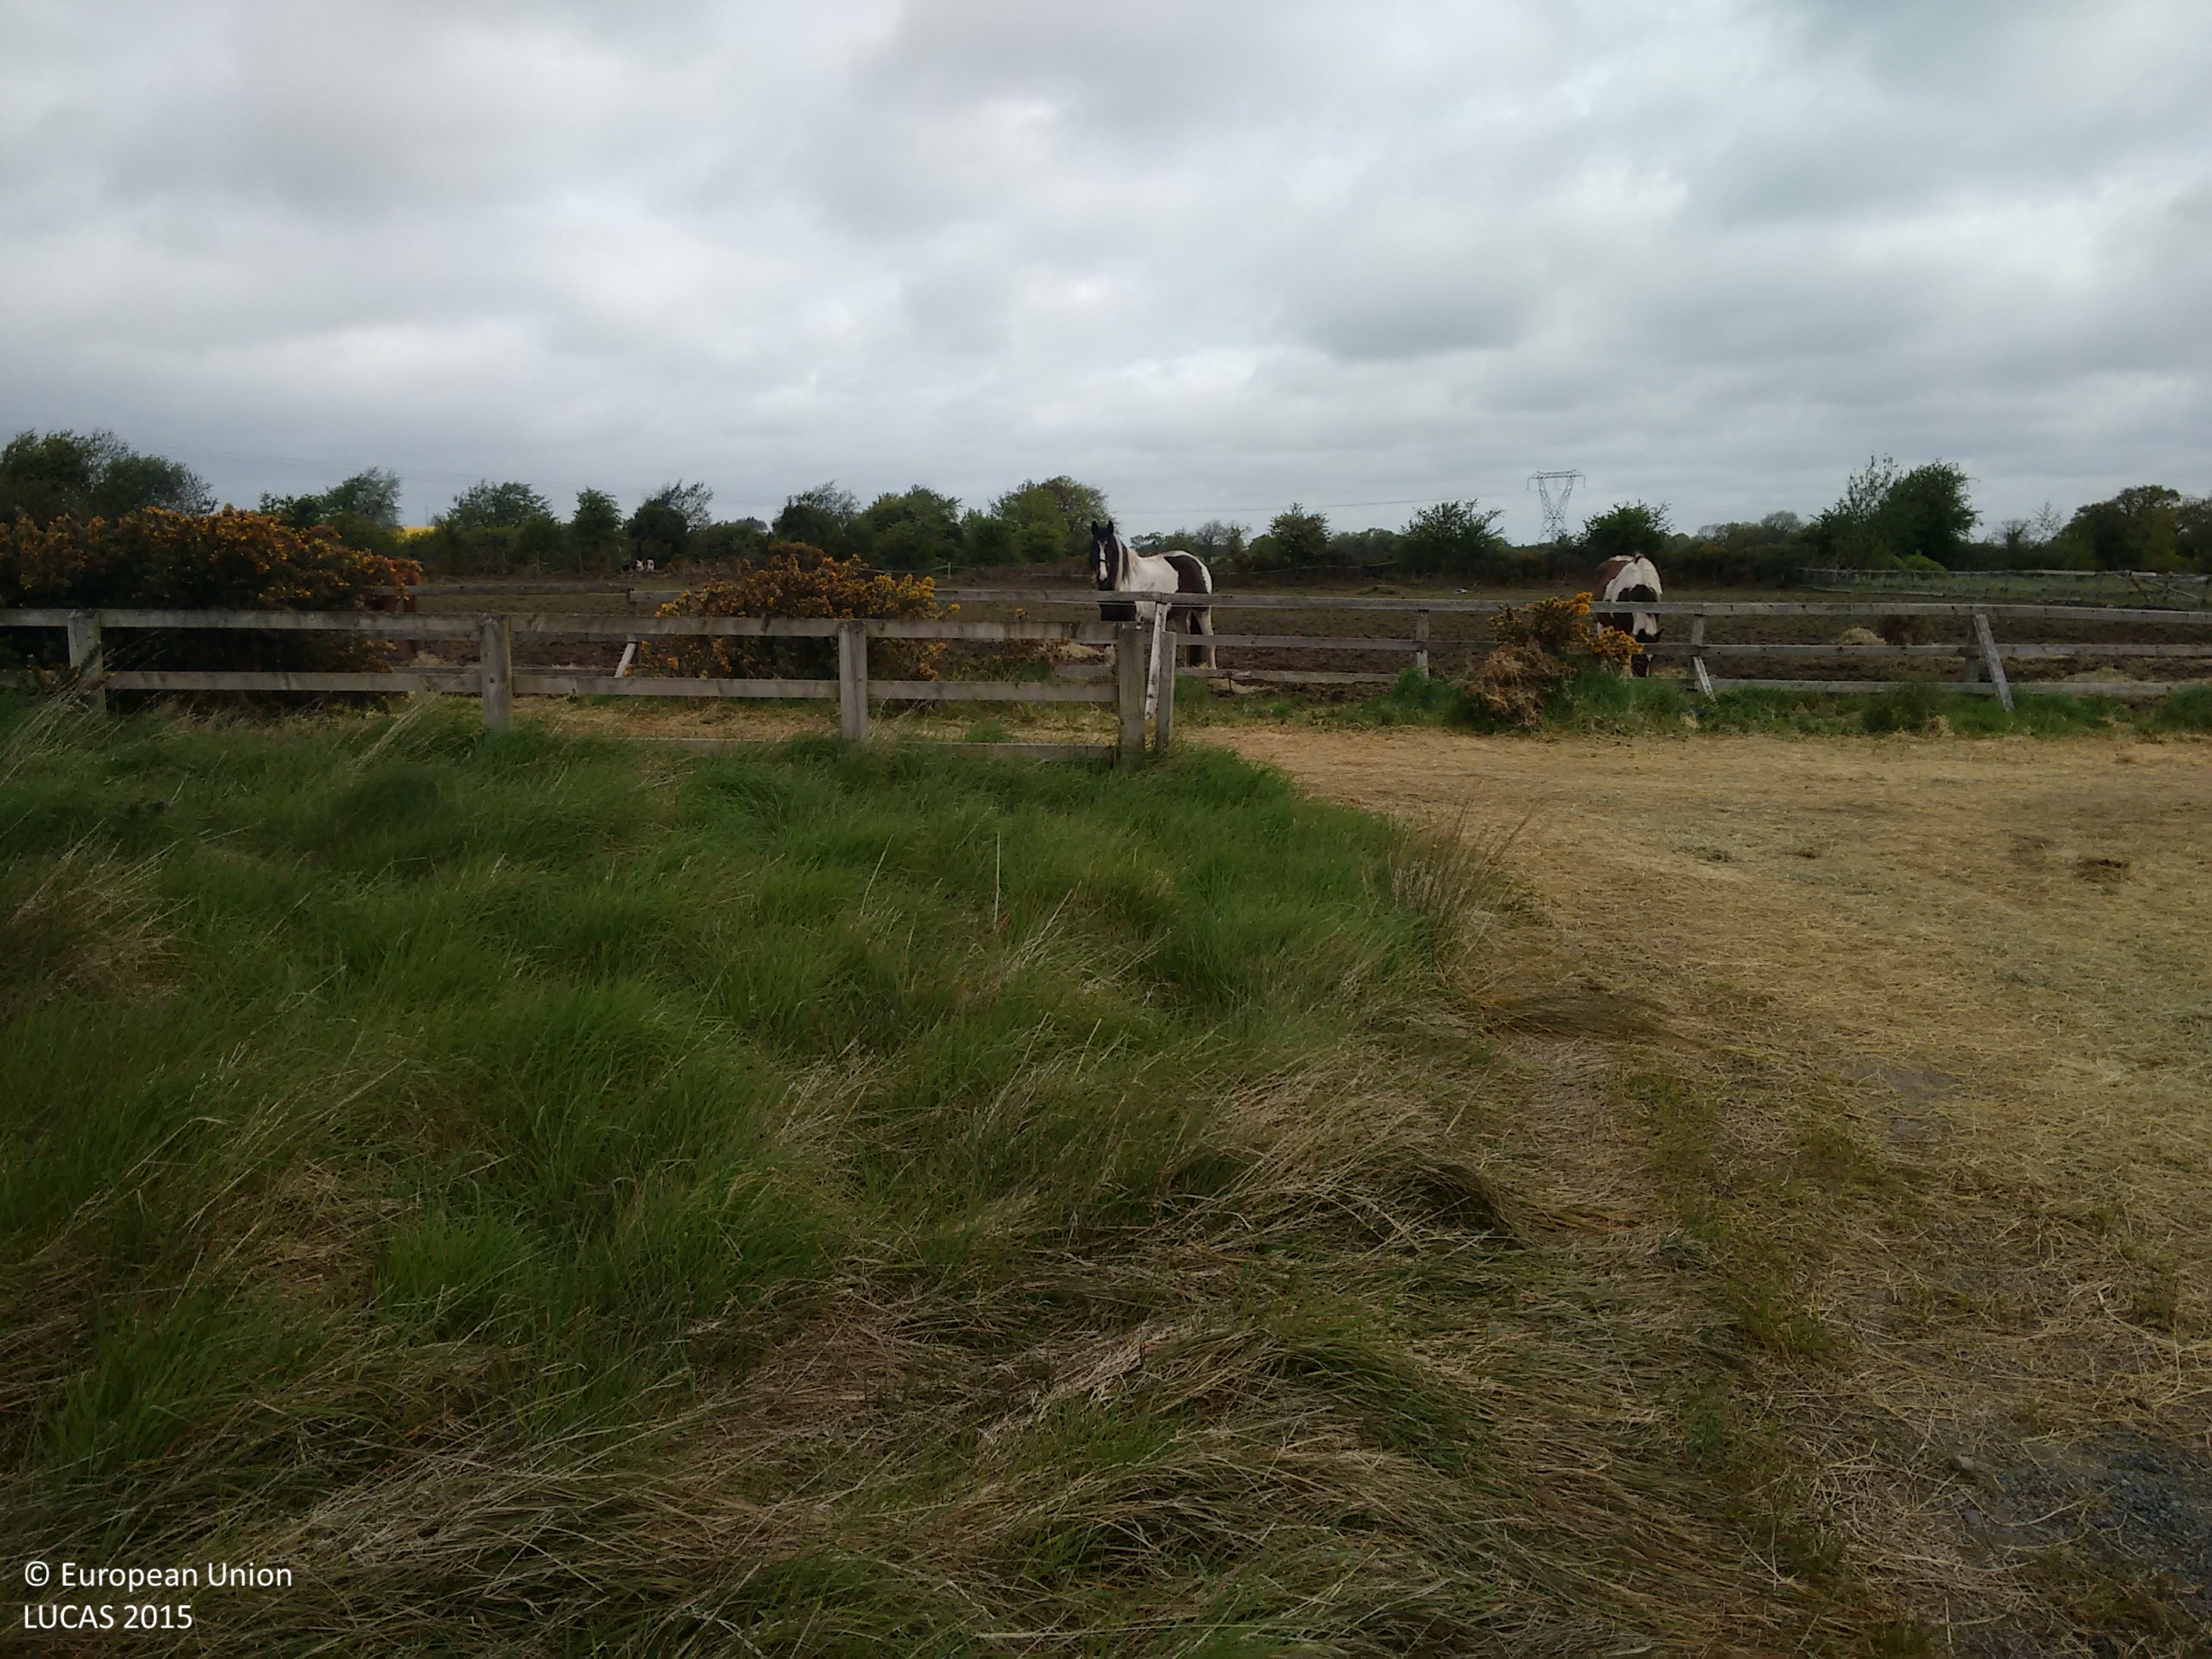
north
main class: Grassland
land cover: Grassland without tree/shrub cover
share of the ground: > 75 %
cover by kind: herbaceous plants 95 %, shrubs 5 %
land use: Abandoned areas
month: May
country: IE
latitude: 53.3206
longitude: -6.6600
